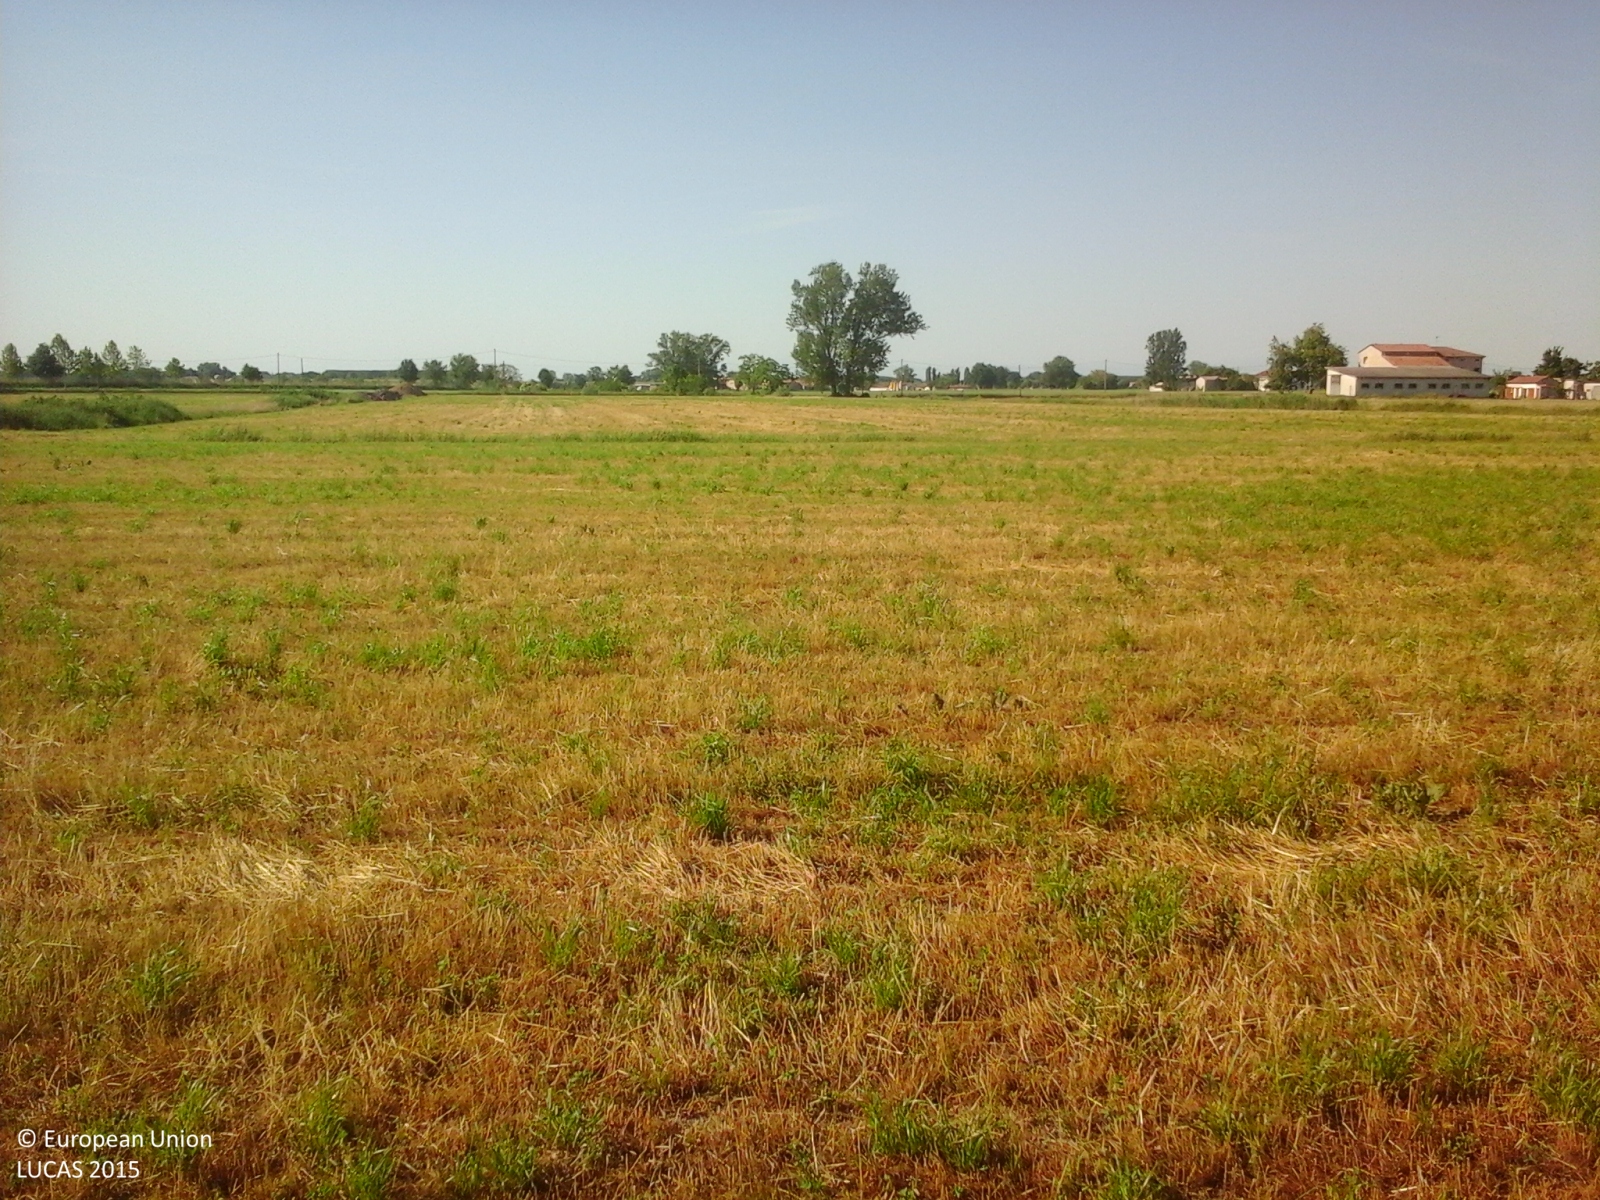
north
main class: Cropland
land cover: Lucerne
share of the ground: > 75 %
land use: Agriculture (excluding fallow land and kitchen gardens)
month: May
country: IT
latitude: 45.0139
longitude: 10.8992
